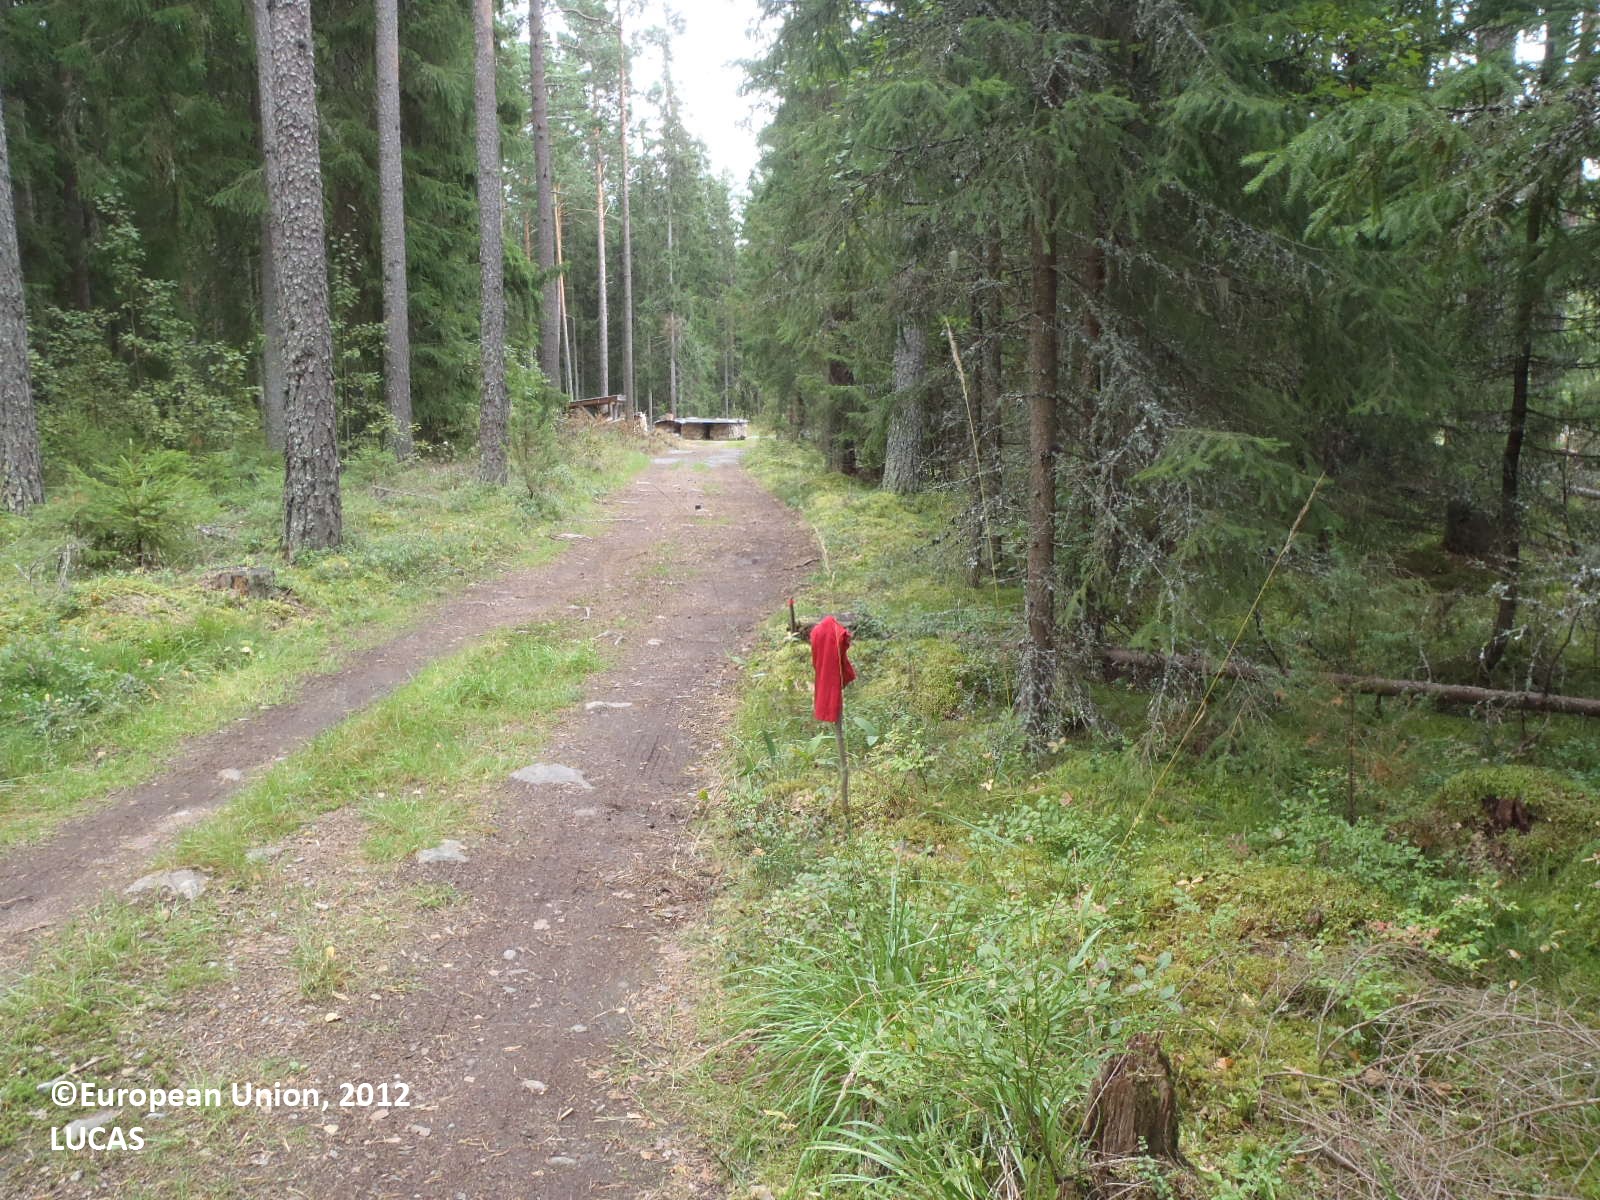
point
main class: Woodland
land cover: Pine dominated coniferous woodland
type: boreal forest
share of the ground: > 75 %
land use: Forestry
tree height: > 5 m
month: August
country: FI
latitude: 60.9051
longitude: 21.8017
